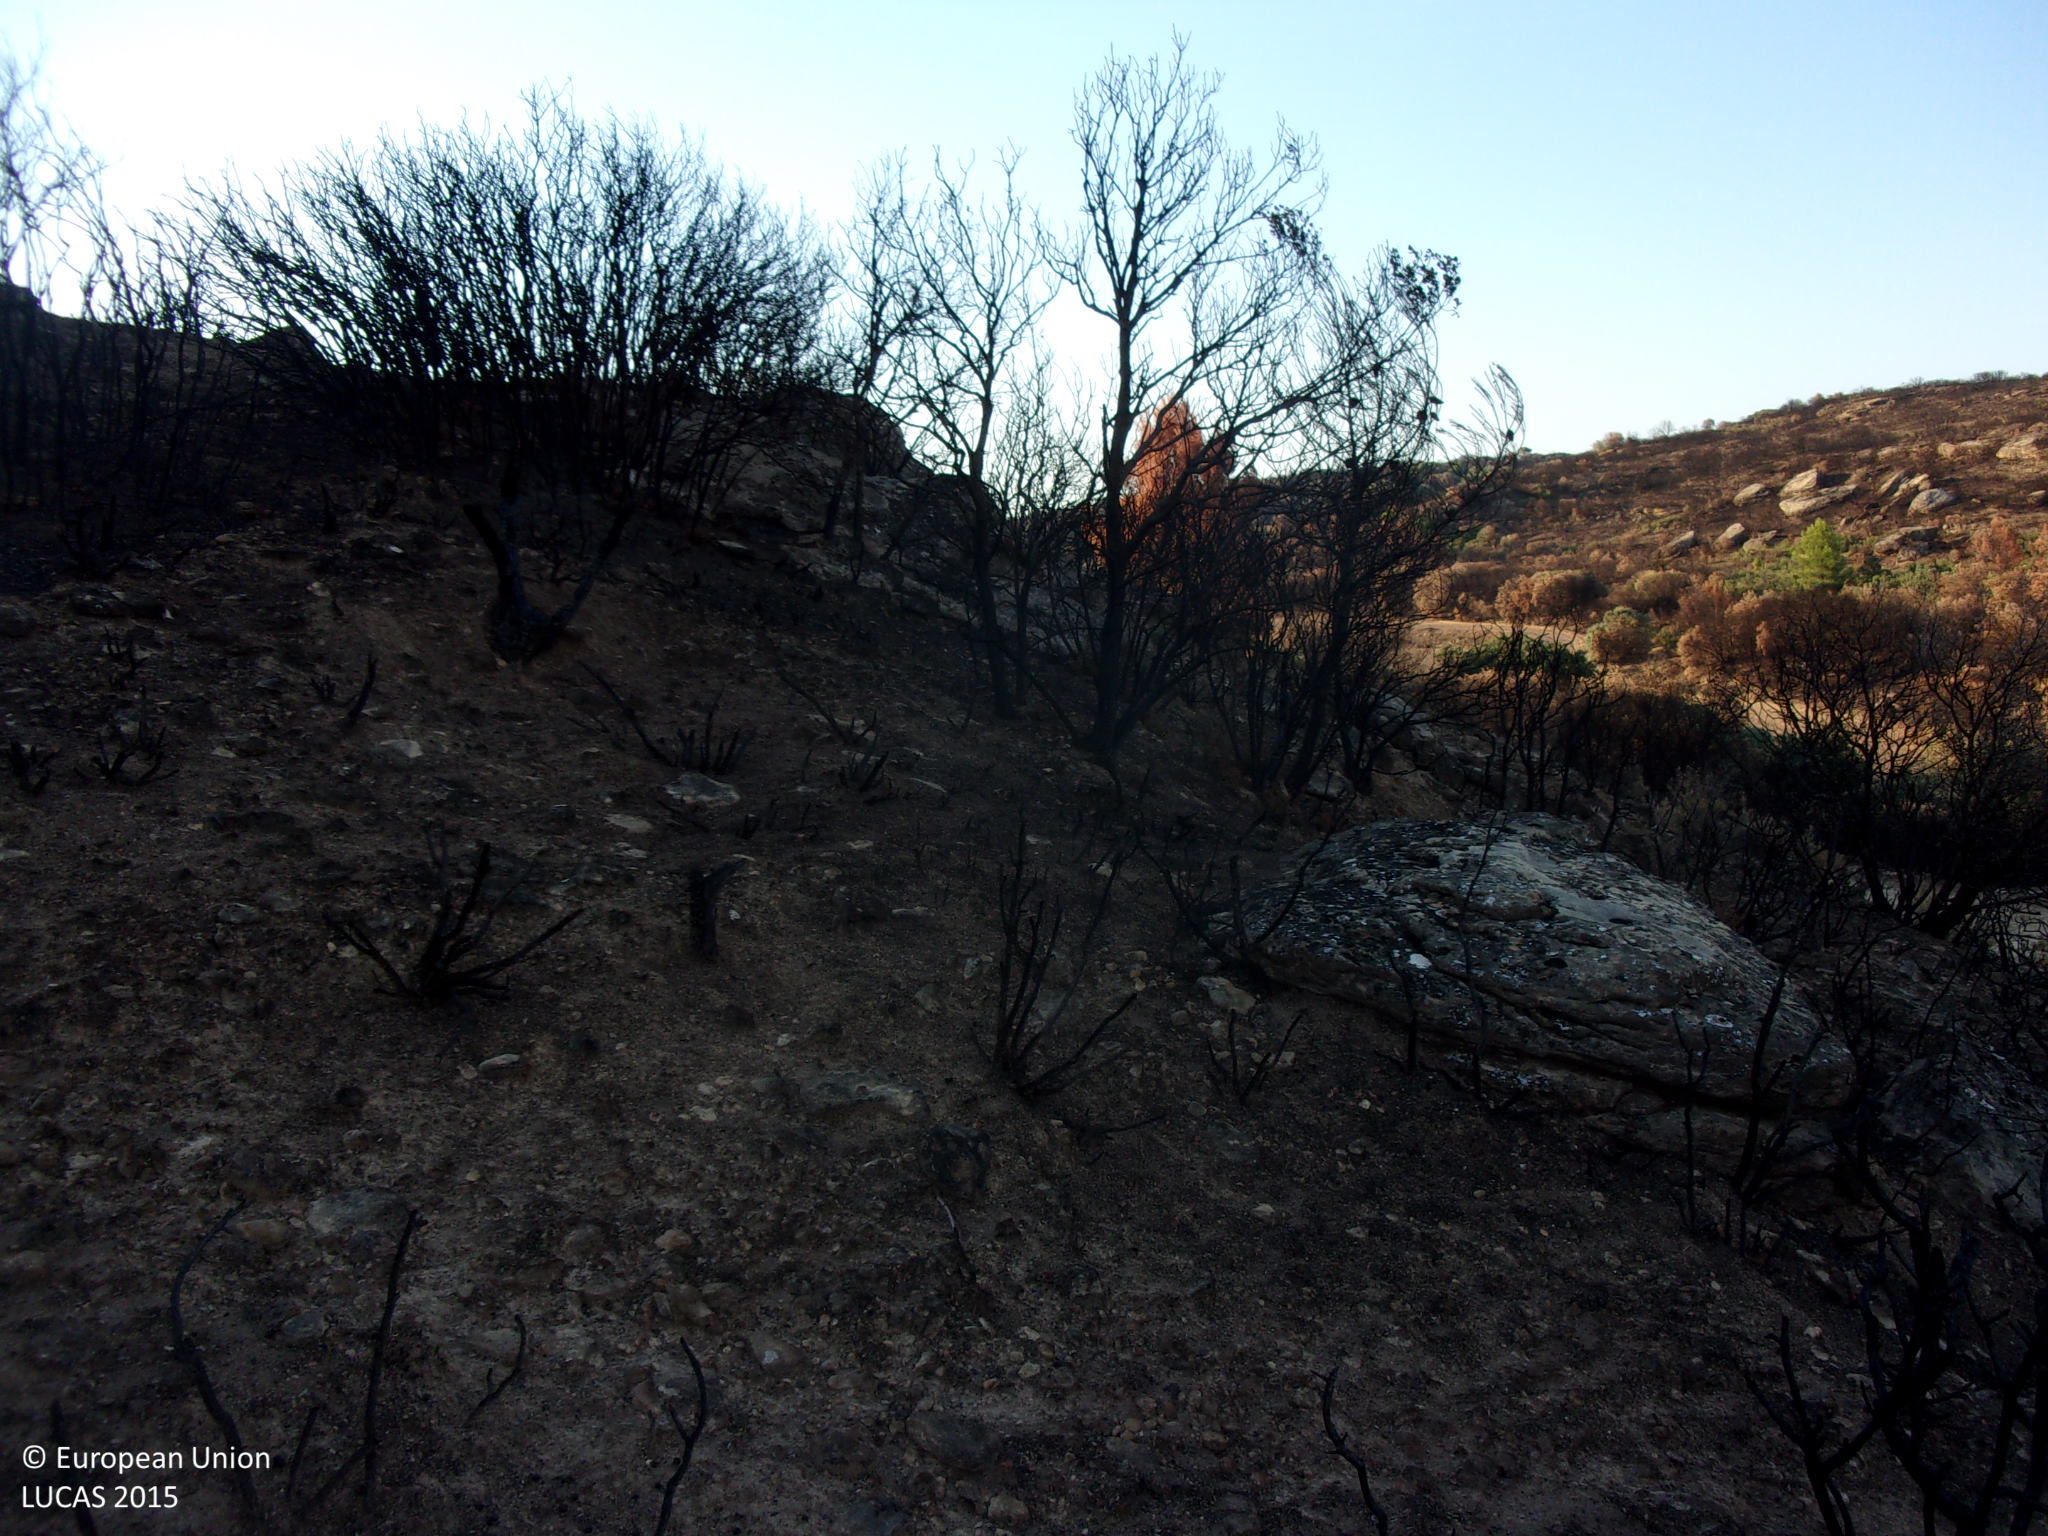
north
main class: Shrubland
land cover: Shrubland with sparse tree cover
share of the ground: 10 - 25 %
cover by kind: unconsolidated bare surface 75 %, shrubs 20 %, broadleaved forest trees 5 %
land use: Semi-natural and natural areas not in use
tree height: < 5 m
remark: Burnt area
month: August
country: ES
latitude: 42.2814
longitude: -1.0761
